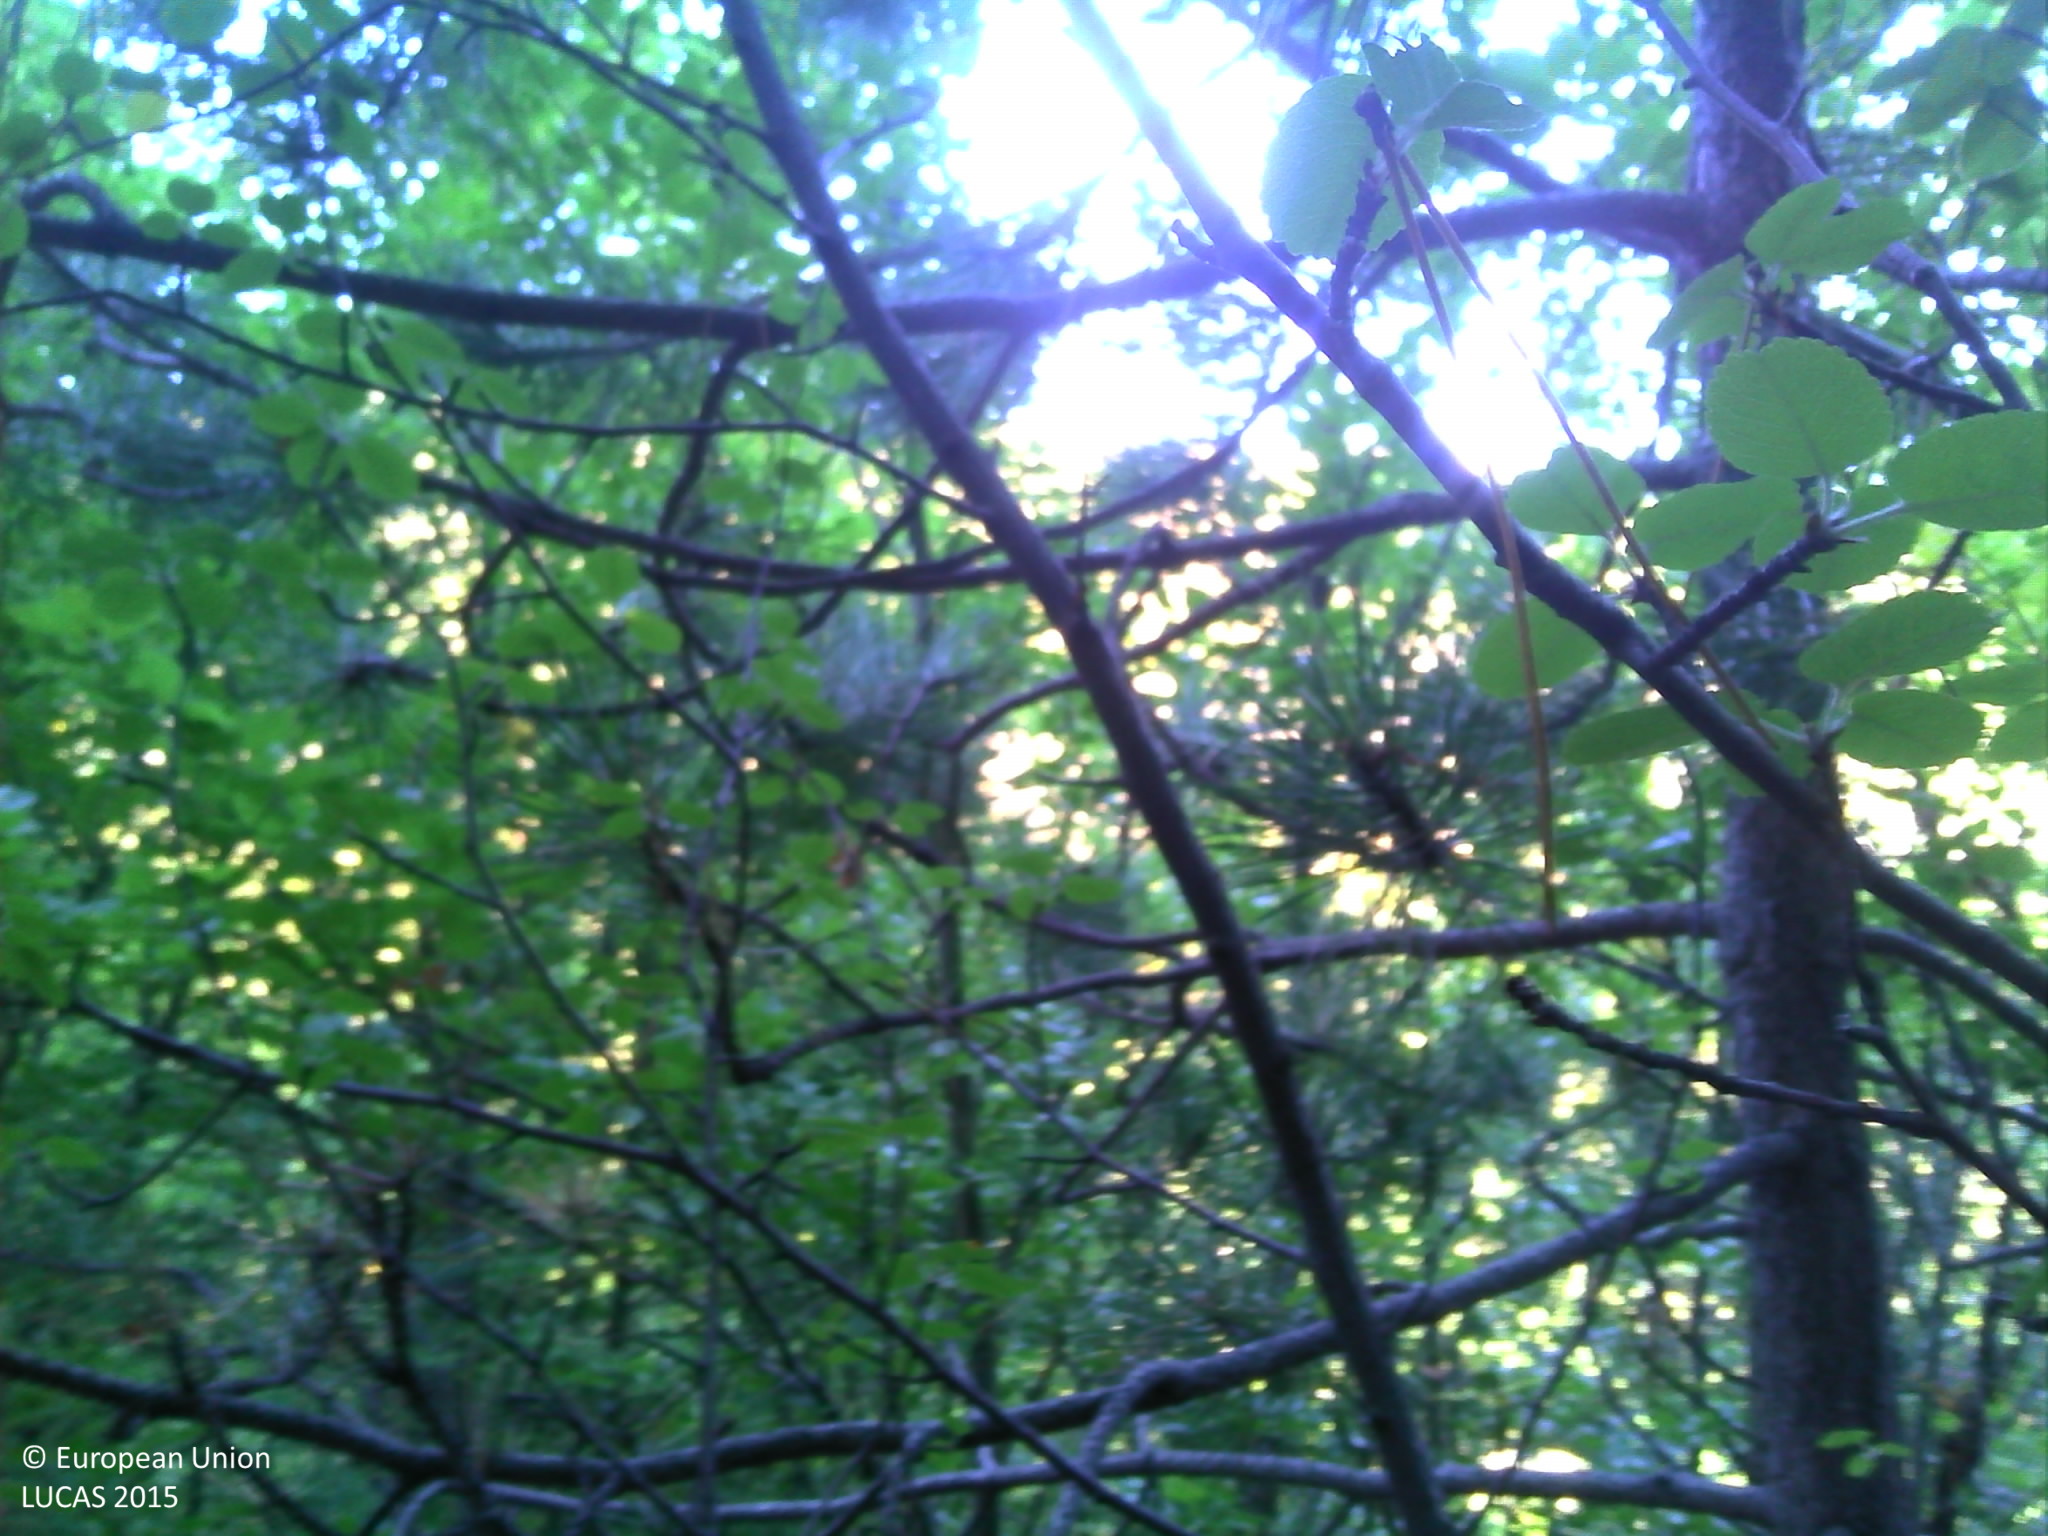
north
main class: Woodland
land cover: Broadleaved woodland
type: beech forest
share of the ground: > 75 %
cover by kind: broadleaved forest trees 85 %, unconsolidated bare surface 10 %, coniferous forest trees 5 %
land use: Semi-natural and natural areas not in use
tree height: > 5 m
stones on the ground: 10 - 25 %
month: September
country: FR
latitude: 44.1815
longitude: 5.5171
